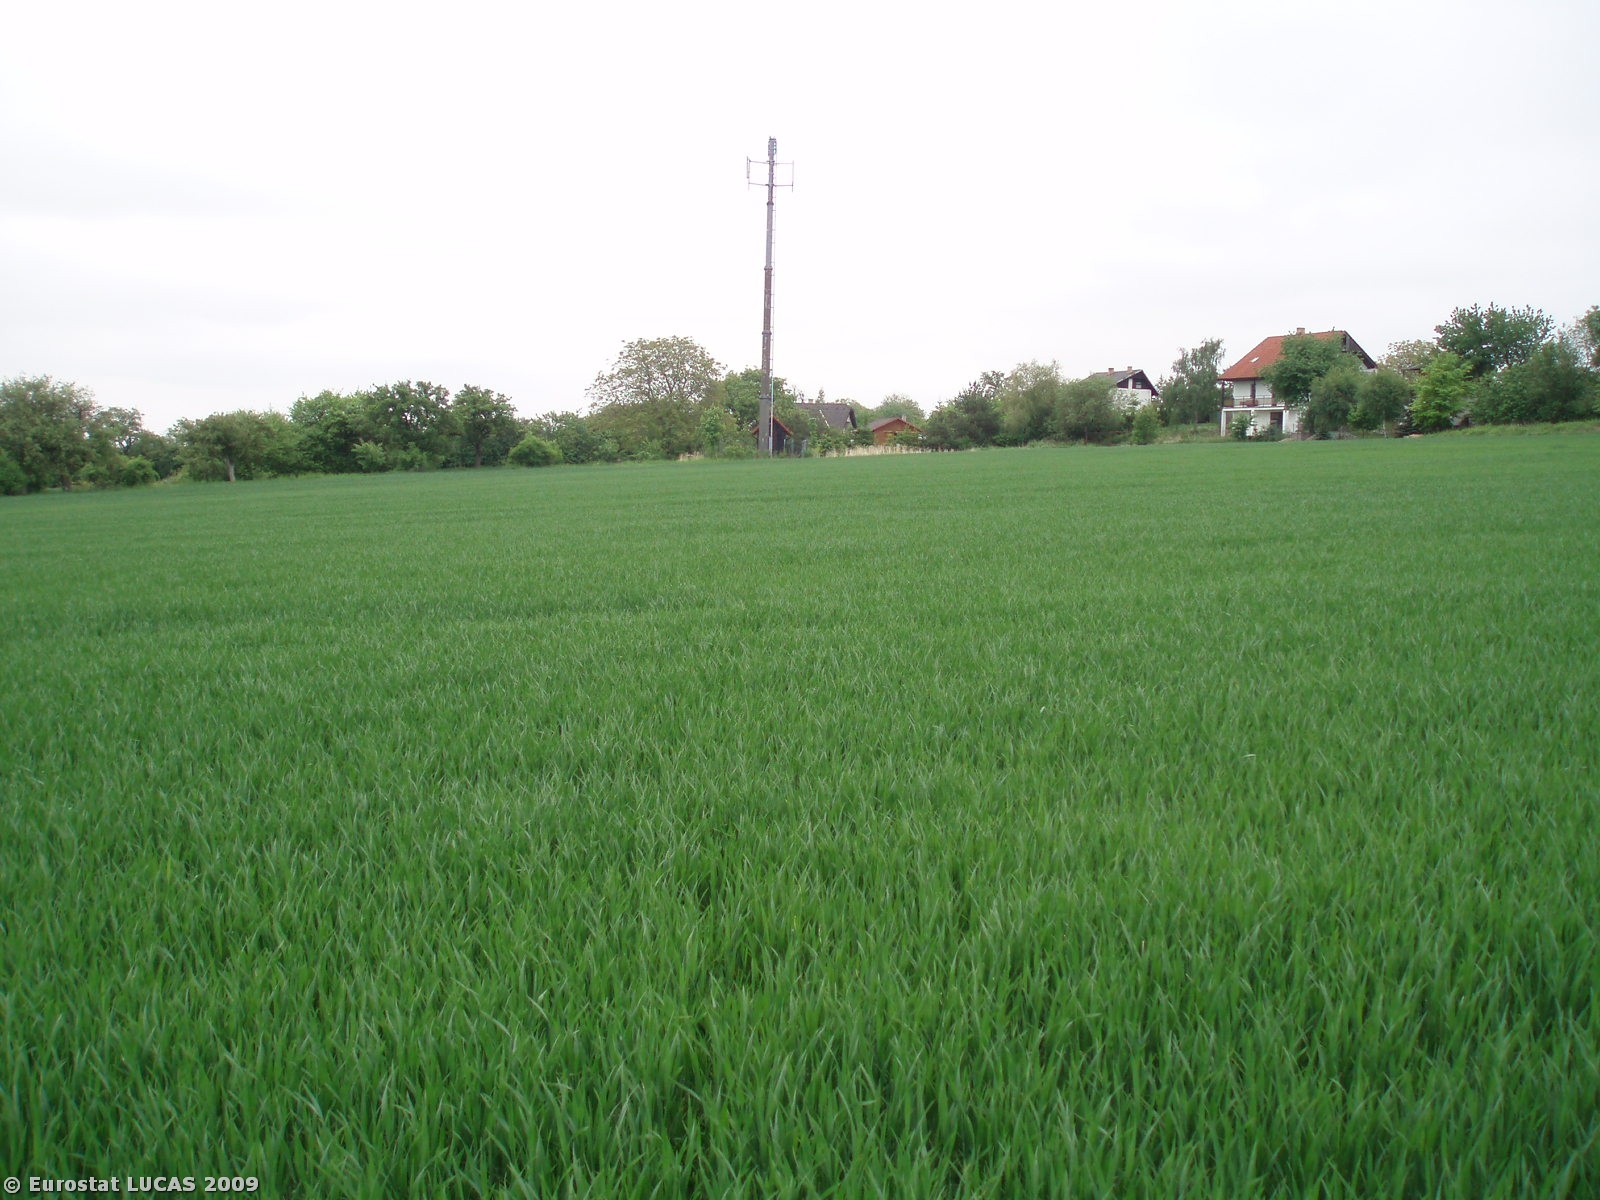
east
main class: Cropland
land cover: Common wheat
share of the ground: > 75 %
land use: Agriculture (excluding fallow land and kitchen gardens)
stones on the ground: < 10 %
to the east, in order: Common wheat; Artificial constructions in urban areas; Paved roads, cycling and walking lanes; Broadleaved woodland; Grassland without tree/shrub cover; Rape and turnip rape
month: May
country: CZ
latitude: 50.0547
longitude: 14.1493
